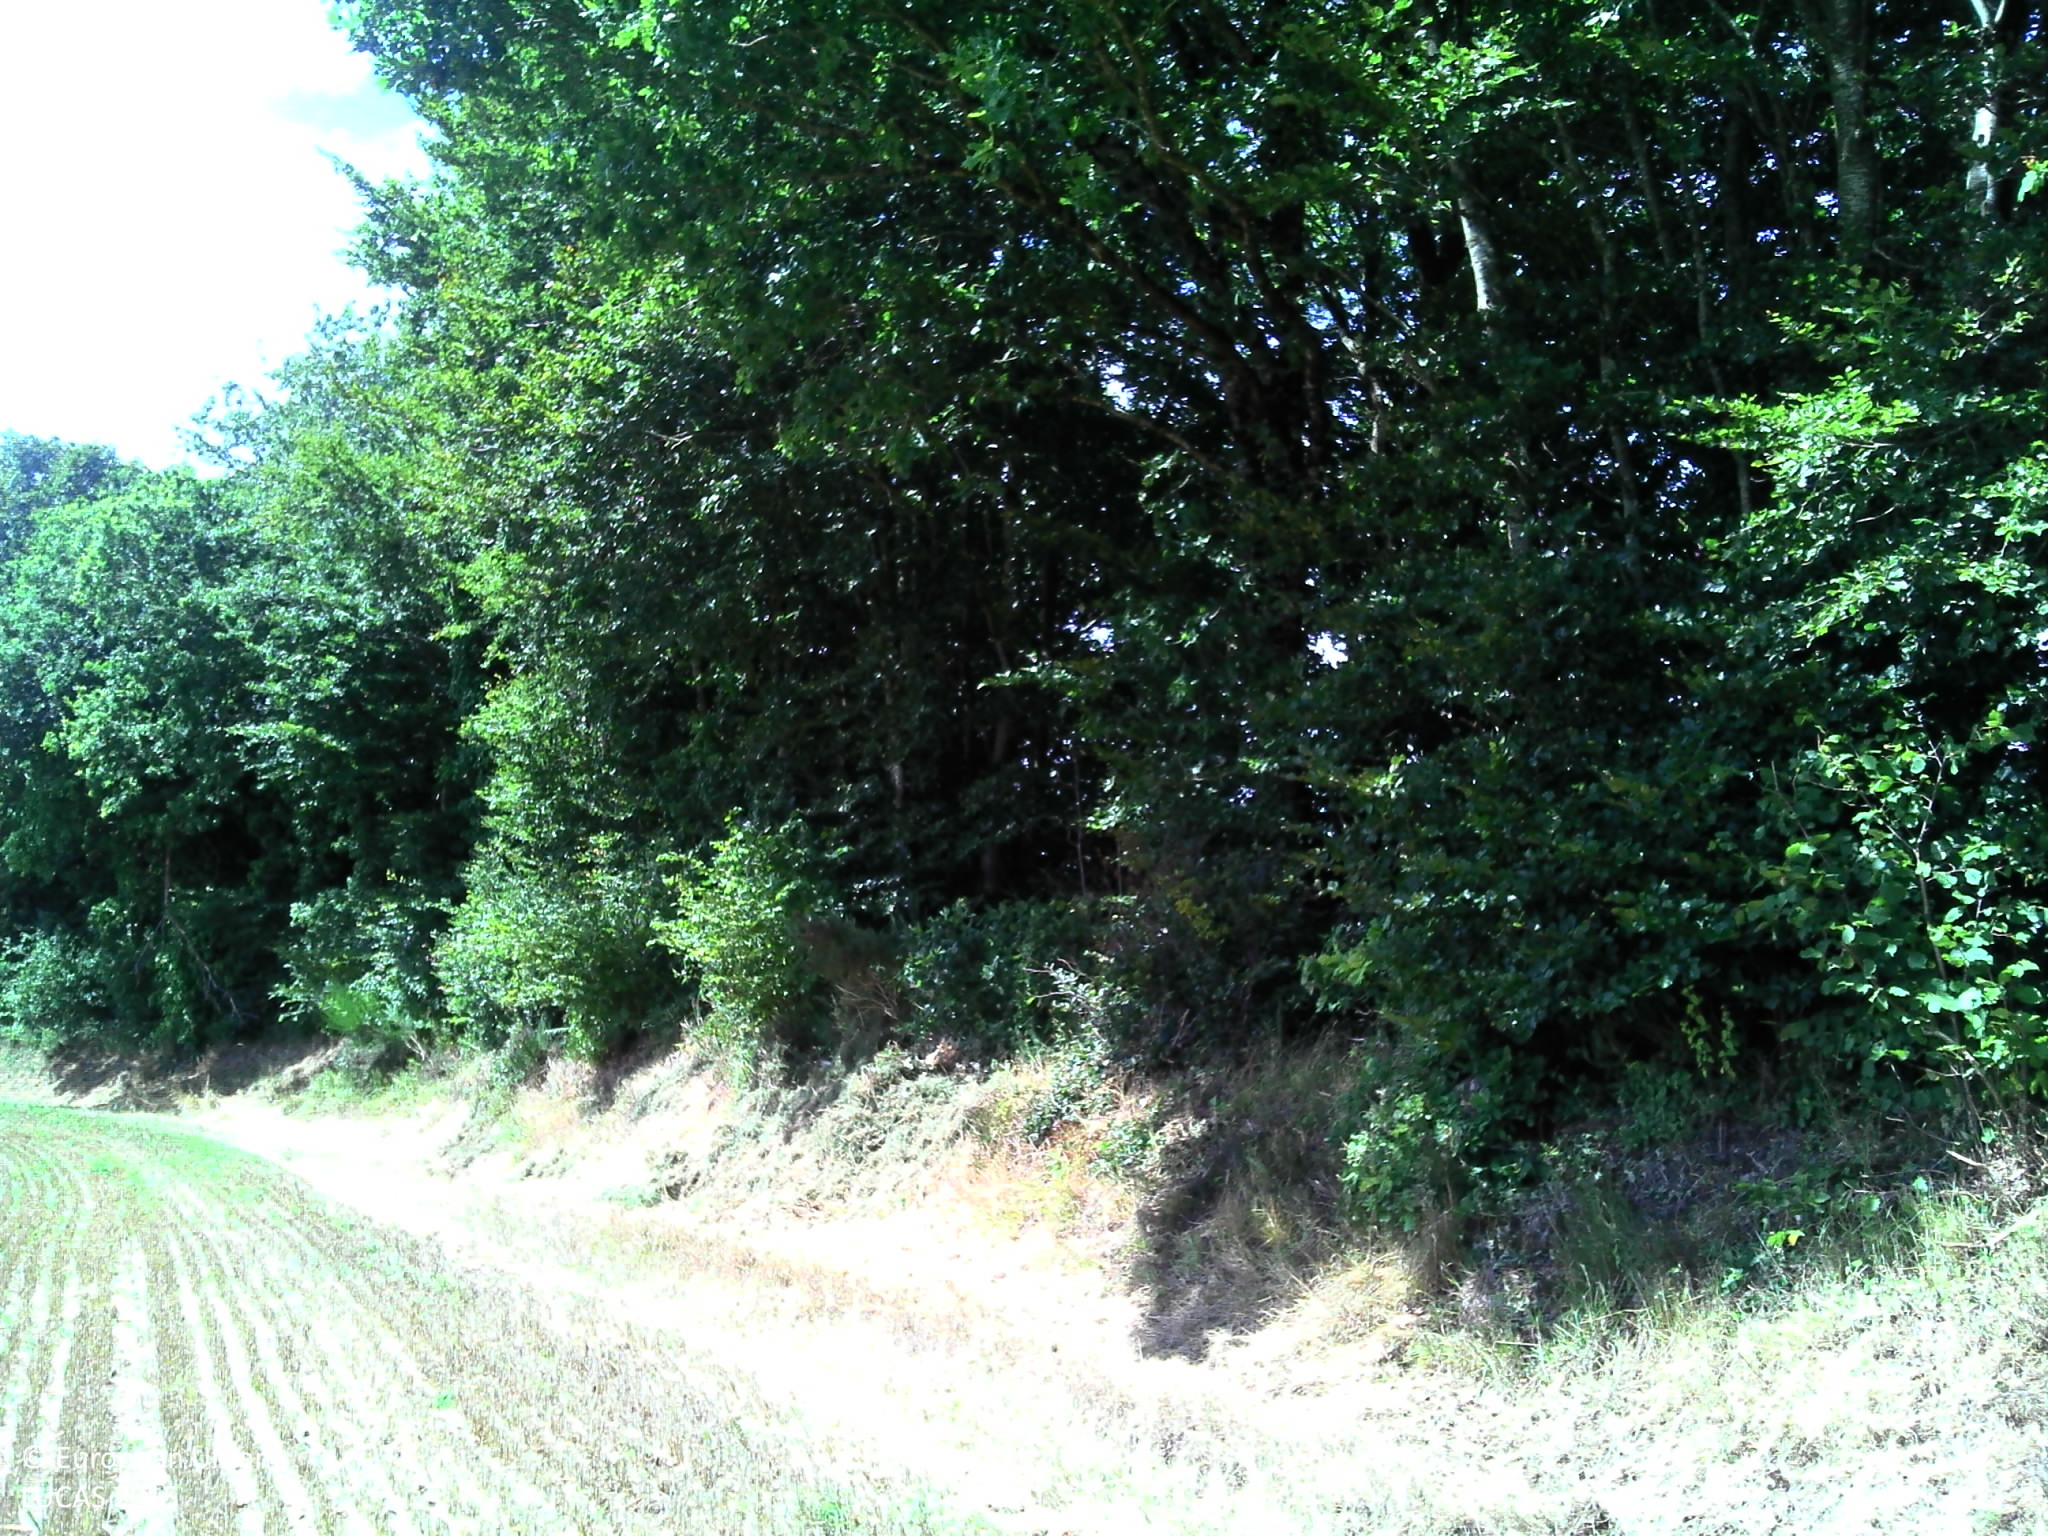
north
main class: Cropland
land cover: Barley
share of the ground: > 75 %
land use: Agriculture (excluding fallow land and kitchen gardens)
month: August
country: FR
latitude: 48.4800
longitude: -3.3750
